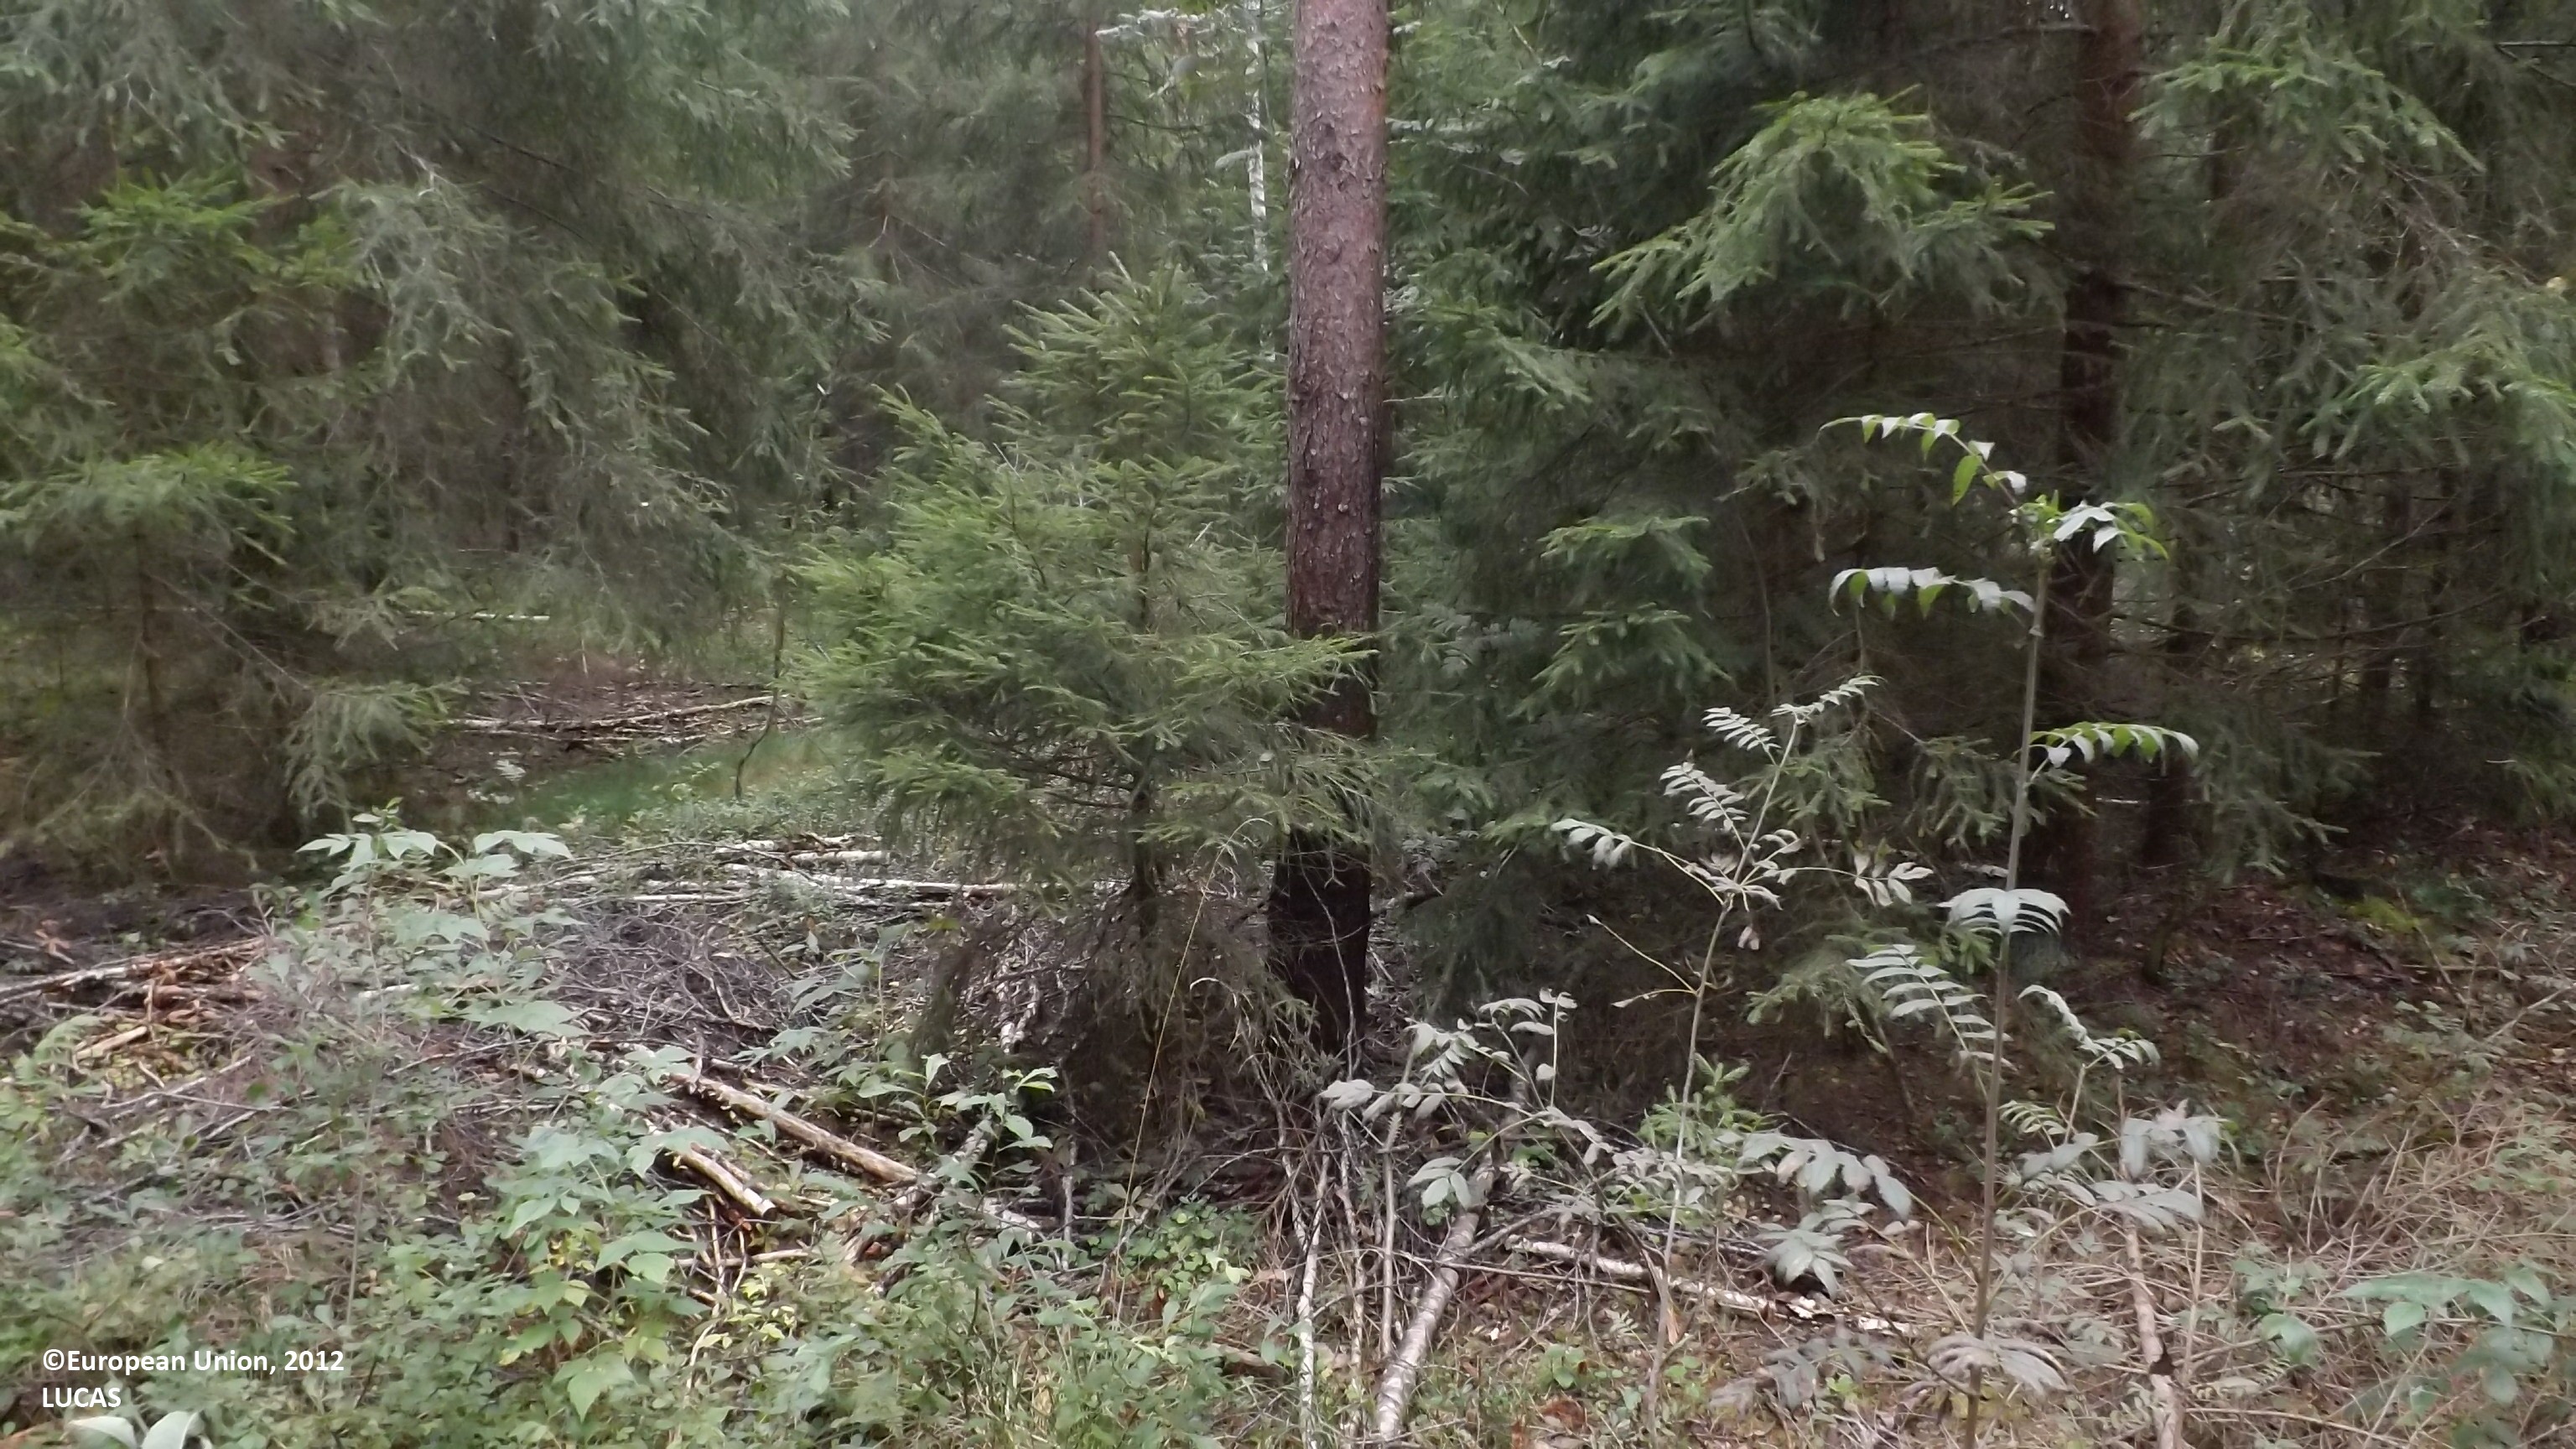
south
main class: Woodland
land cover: Other mixed woodland
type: boreal forest
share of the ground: 50 - 75 %
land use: Forestry
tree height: > 5 m
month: August
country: FI
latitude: 63.7731
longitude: 23.3824
